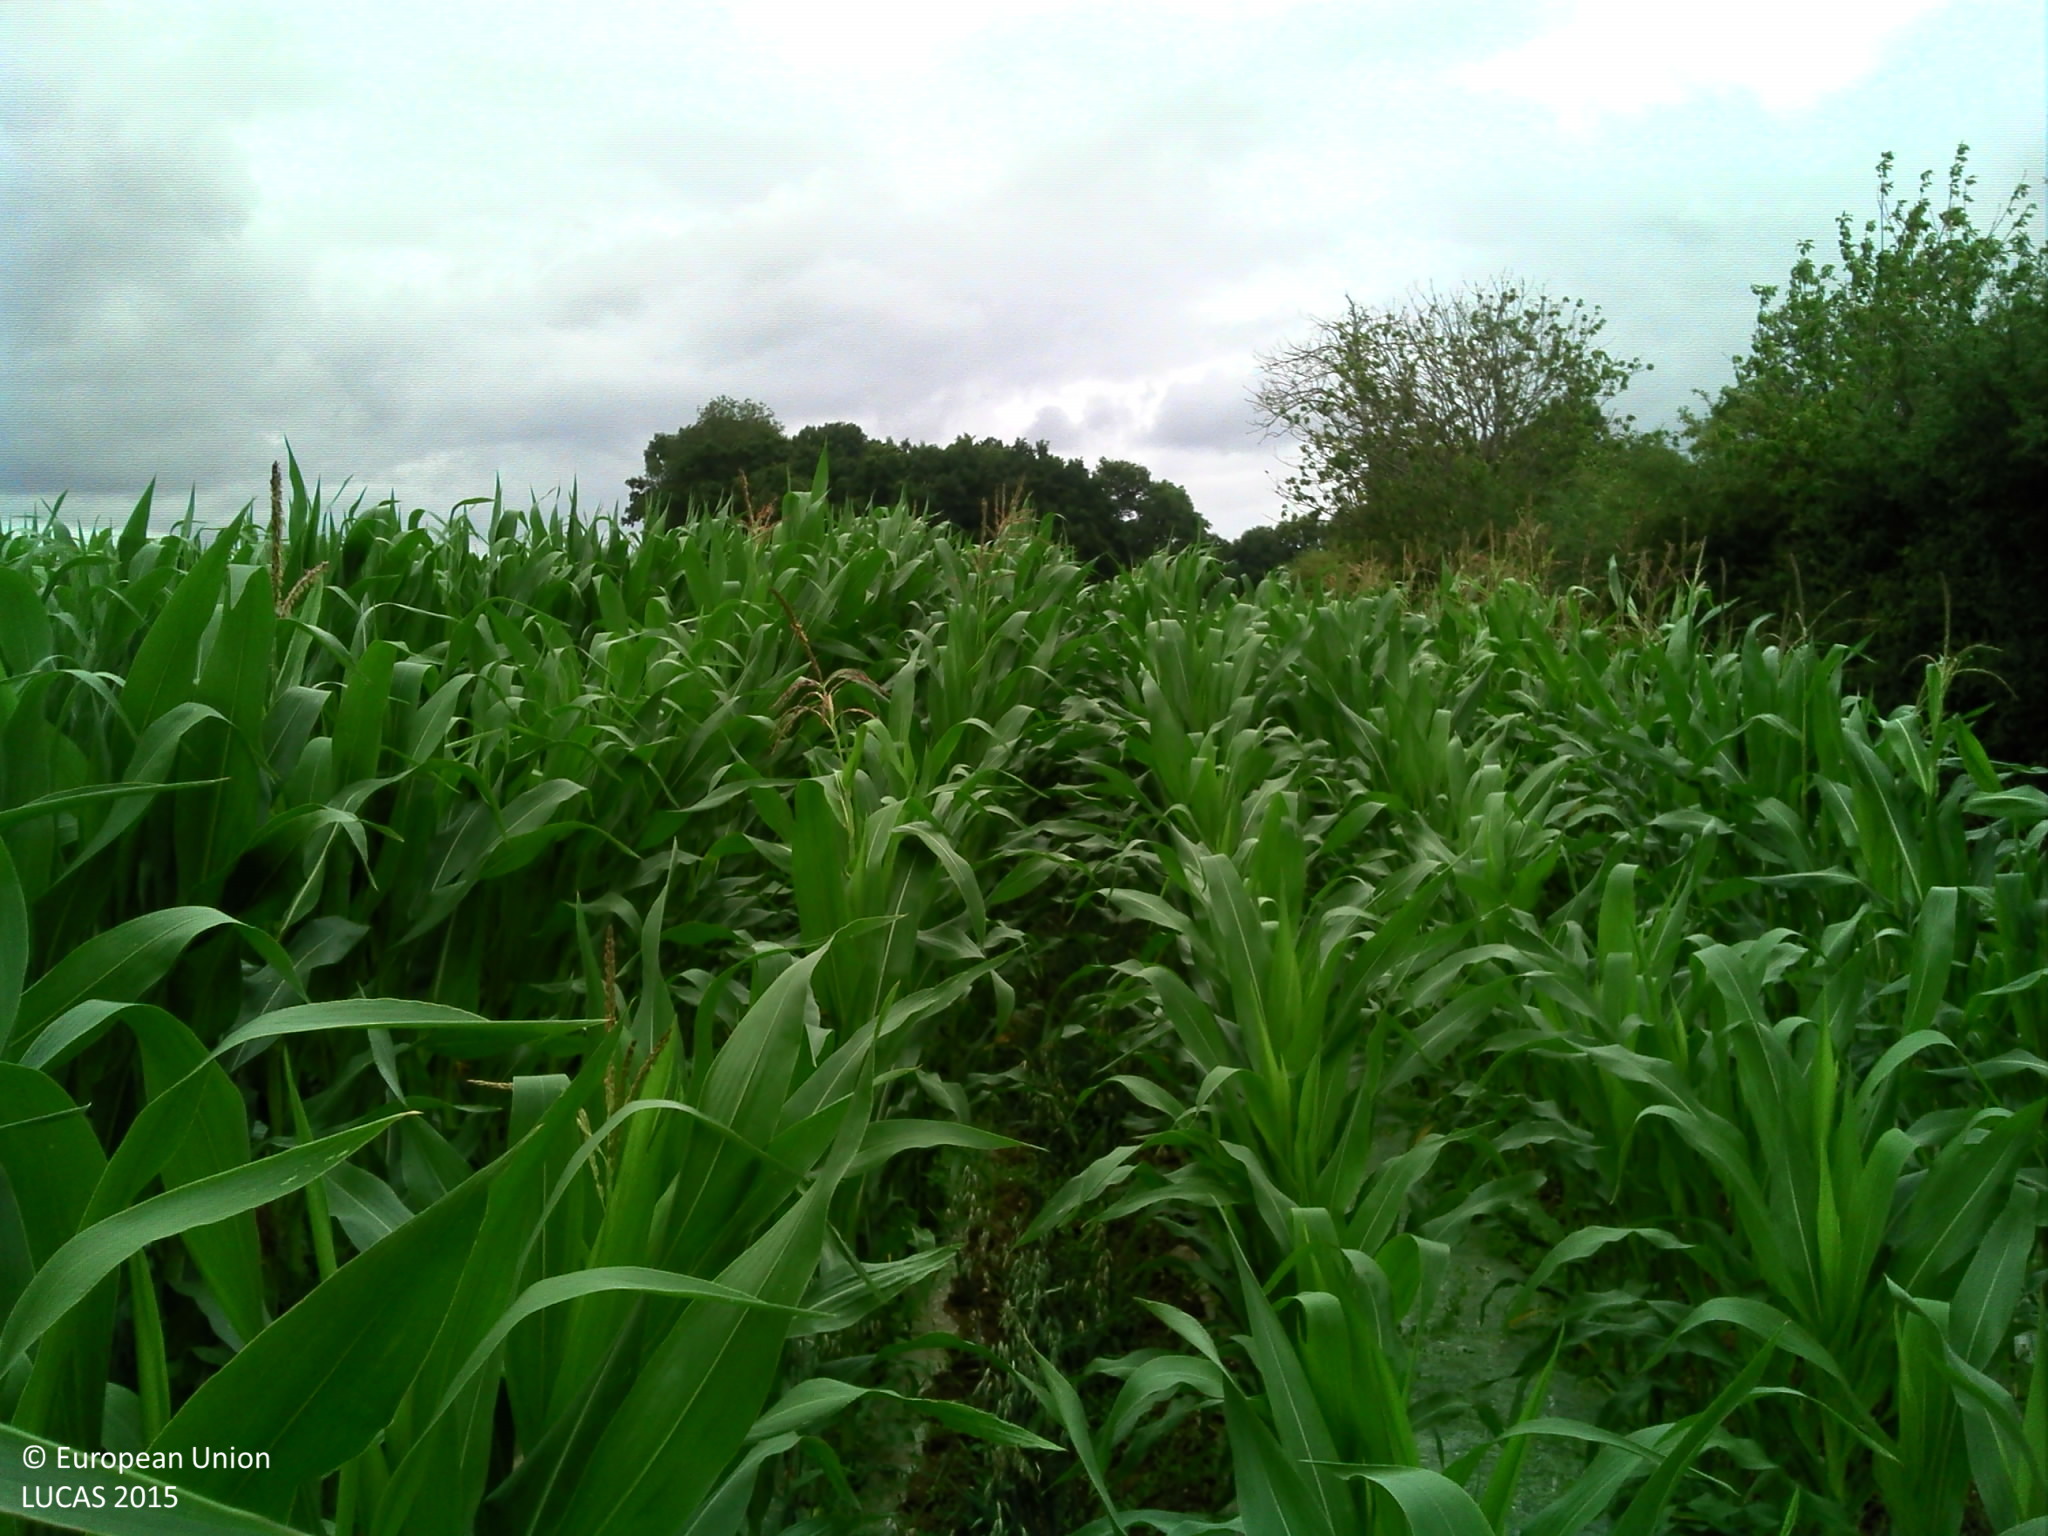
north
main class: Cropland
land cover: Maize
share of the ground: > 75 %
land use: Agriculture (excluding fallow land and kitchen gardens)
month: July
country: FR
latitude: 47.8845
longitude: -2.0748
